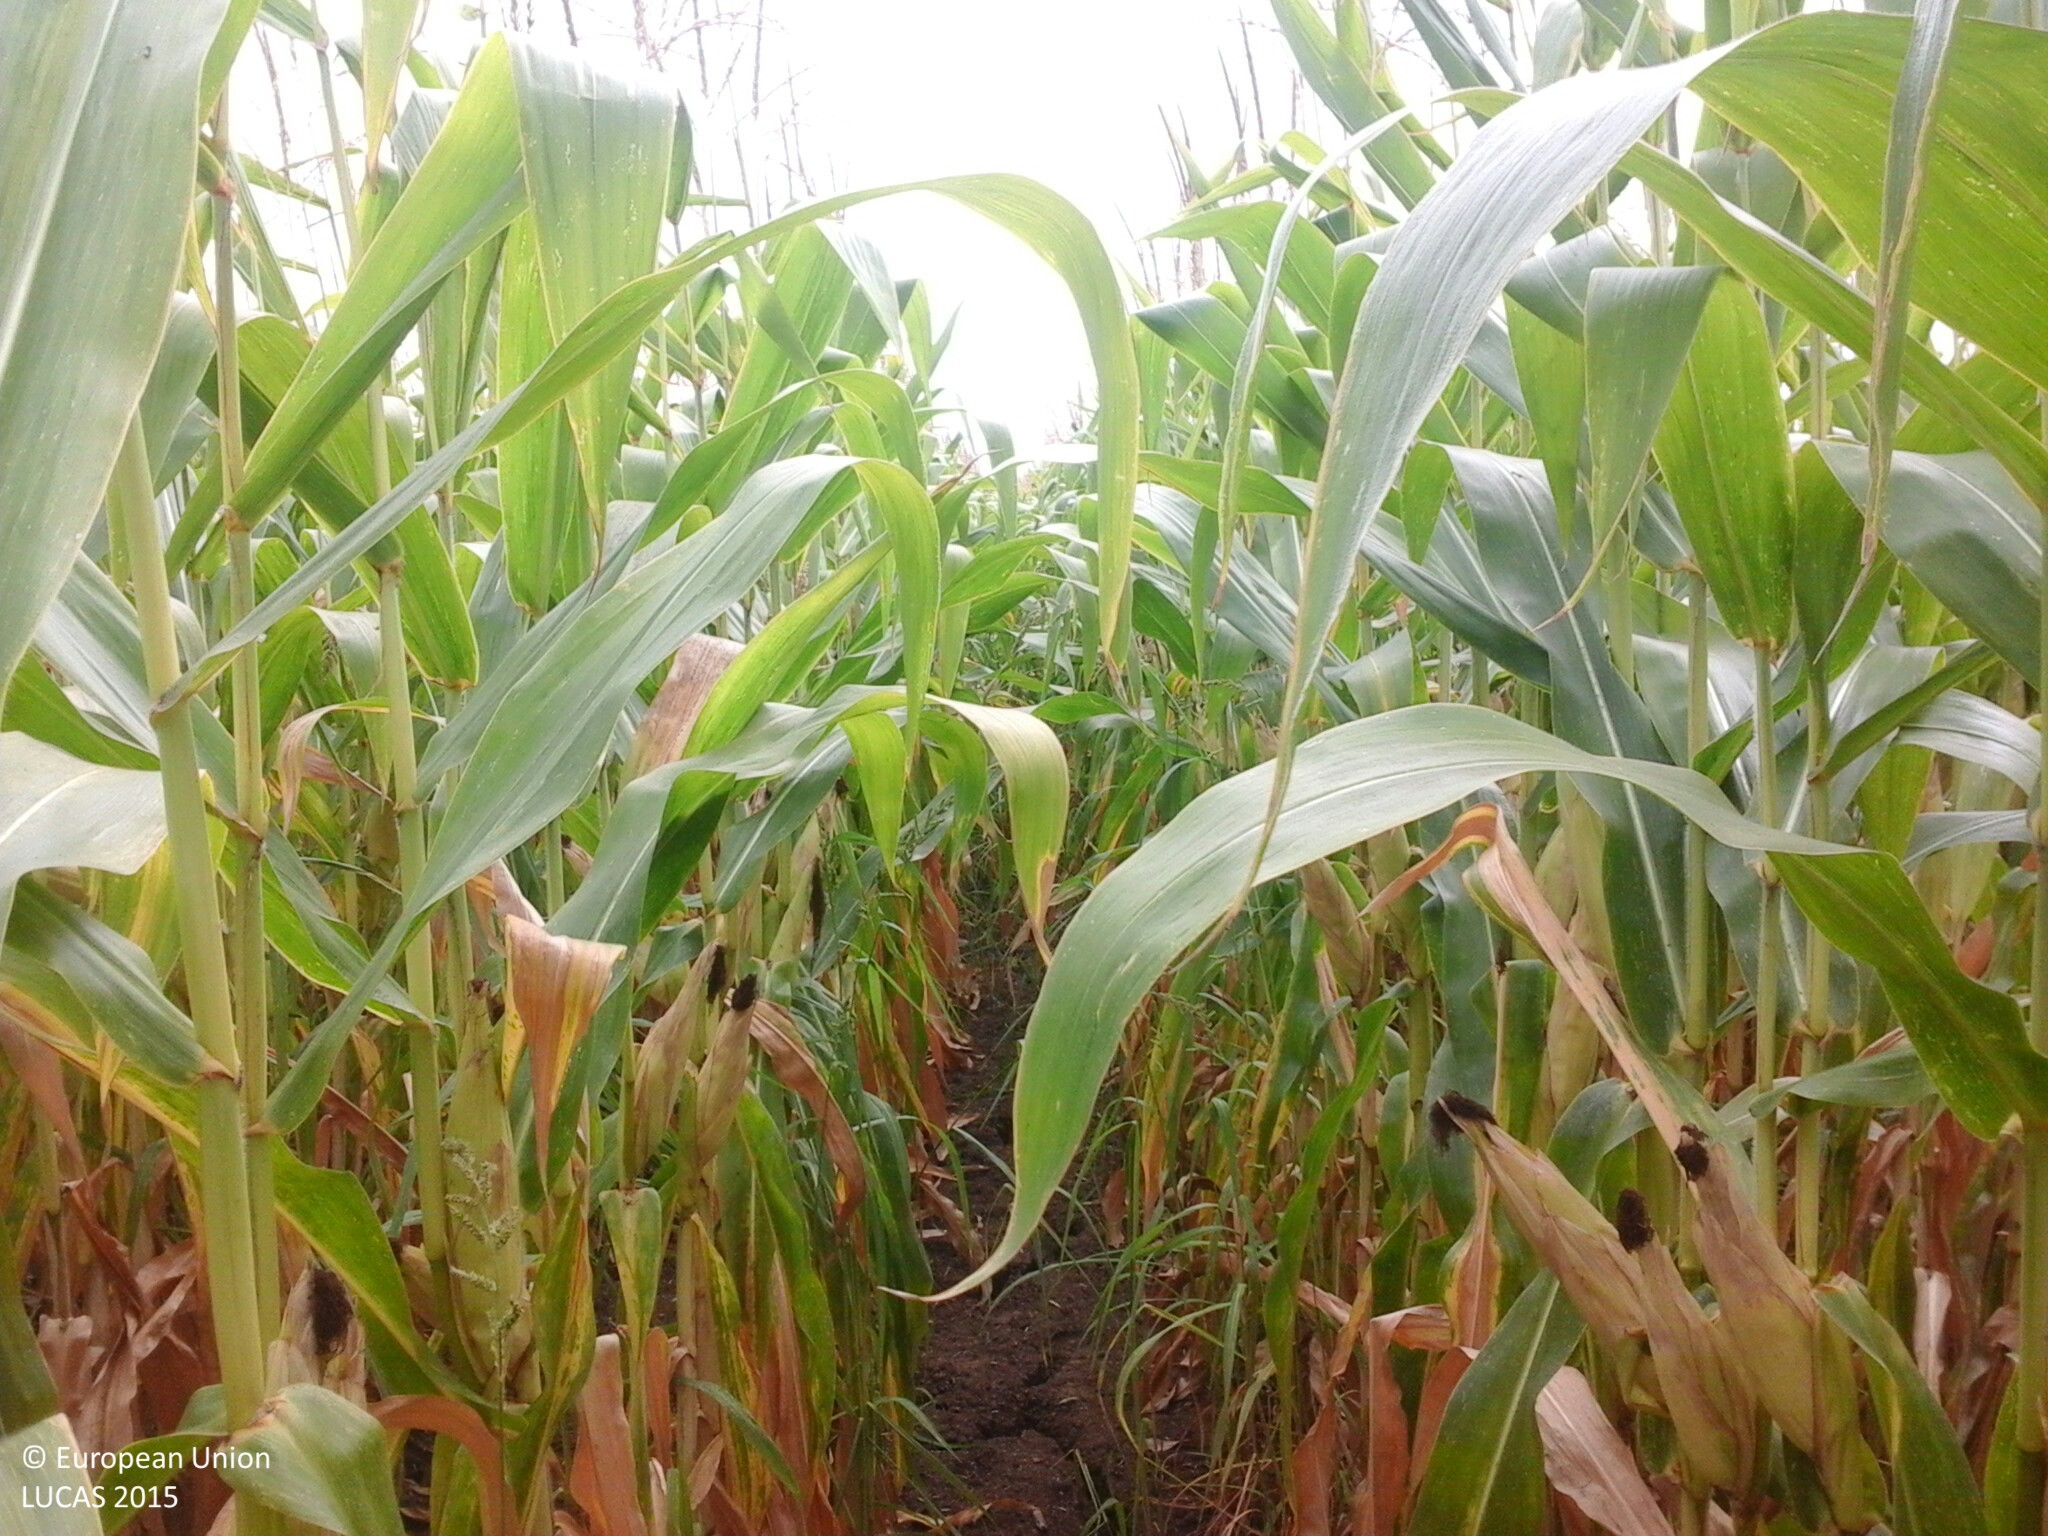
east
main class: Cropland
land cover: Maize
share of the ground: > 75 %
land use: Agriculture (excluding fallow land and kitchen gardens)
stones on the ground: < 10 %
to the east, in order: Maize
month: August
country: HU
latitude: 46.9814
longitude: 21.5175
